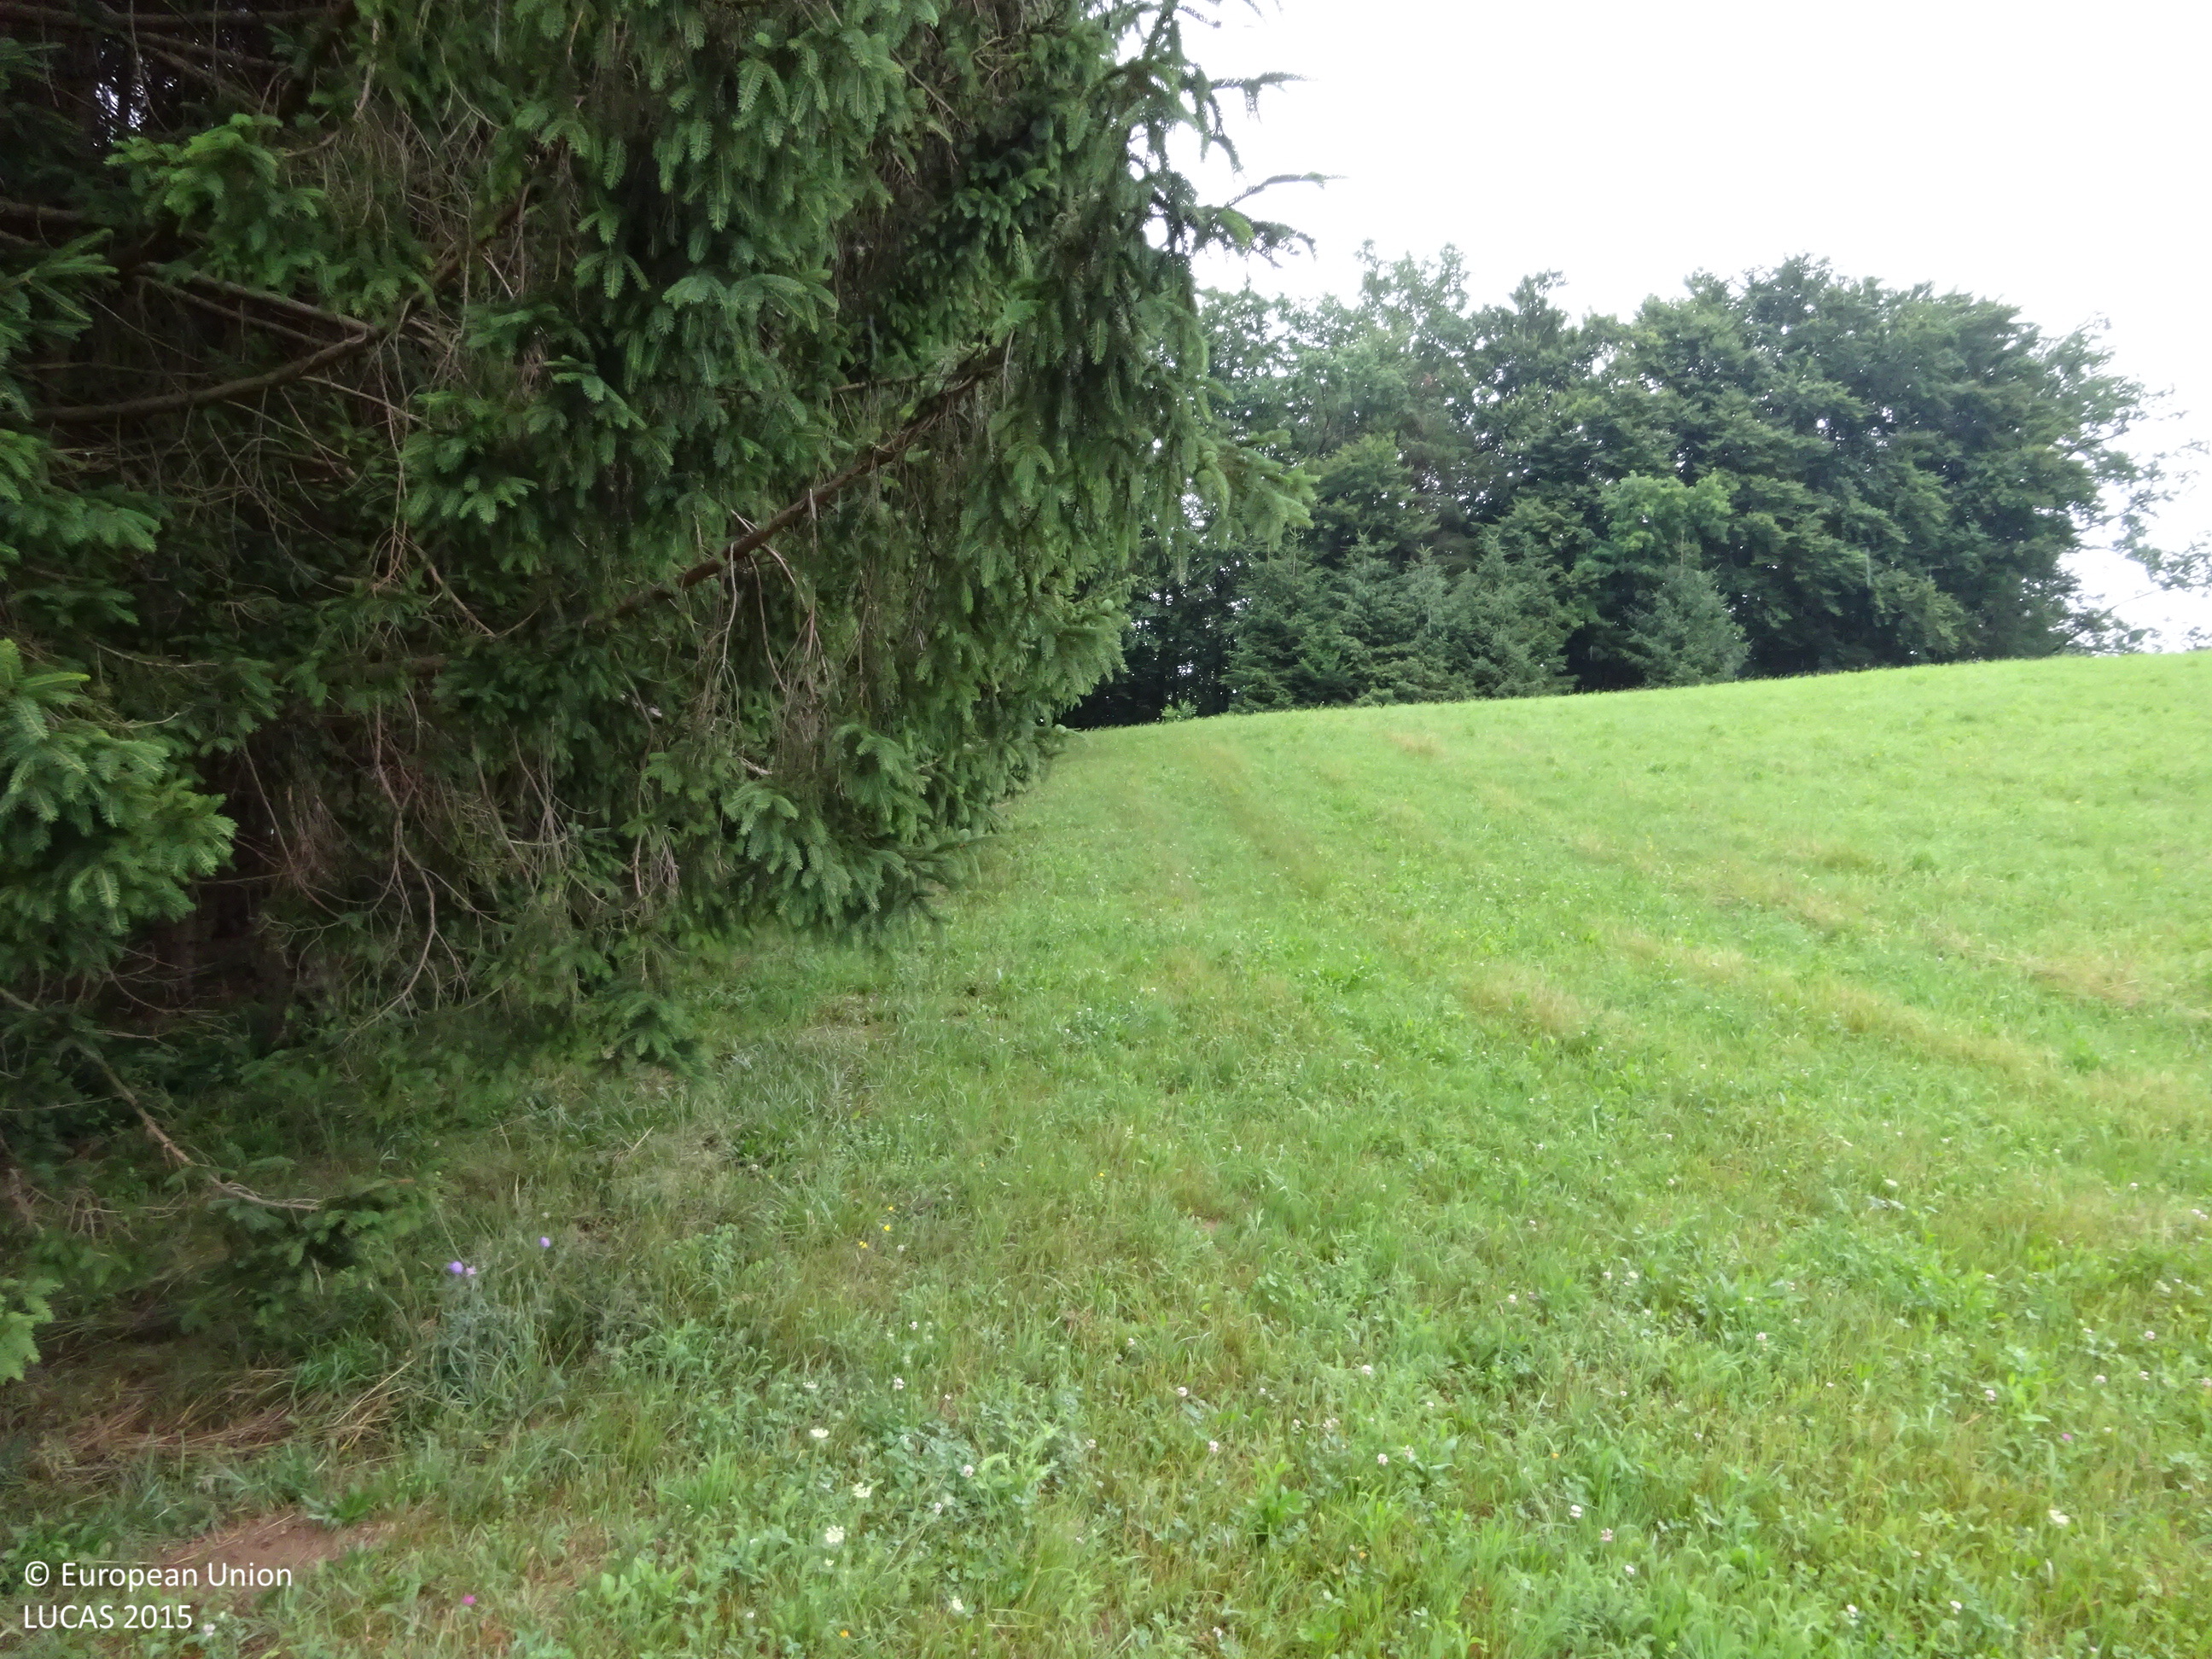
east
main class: Grassland
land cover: Grassland without tree/shrub cover
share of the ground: > 75 %
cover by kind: herbaceous plants 100 %
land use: Agriculture (excluding fallow land and kitchen gardens)
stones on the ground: < 10 %
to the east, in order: Grassland without tree/shrub cover; Spruce dominated coniferous woodland; Grassland without tree/shrub cover; Ditches and canals; Paved roads, cycling and walking lanes; Pine dominated mixed woodland; Spruce dominated mixed woodland; Pine dominated mixed woodland
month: June
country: AT
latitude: 46.7393
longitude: 15.3781
